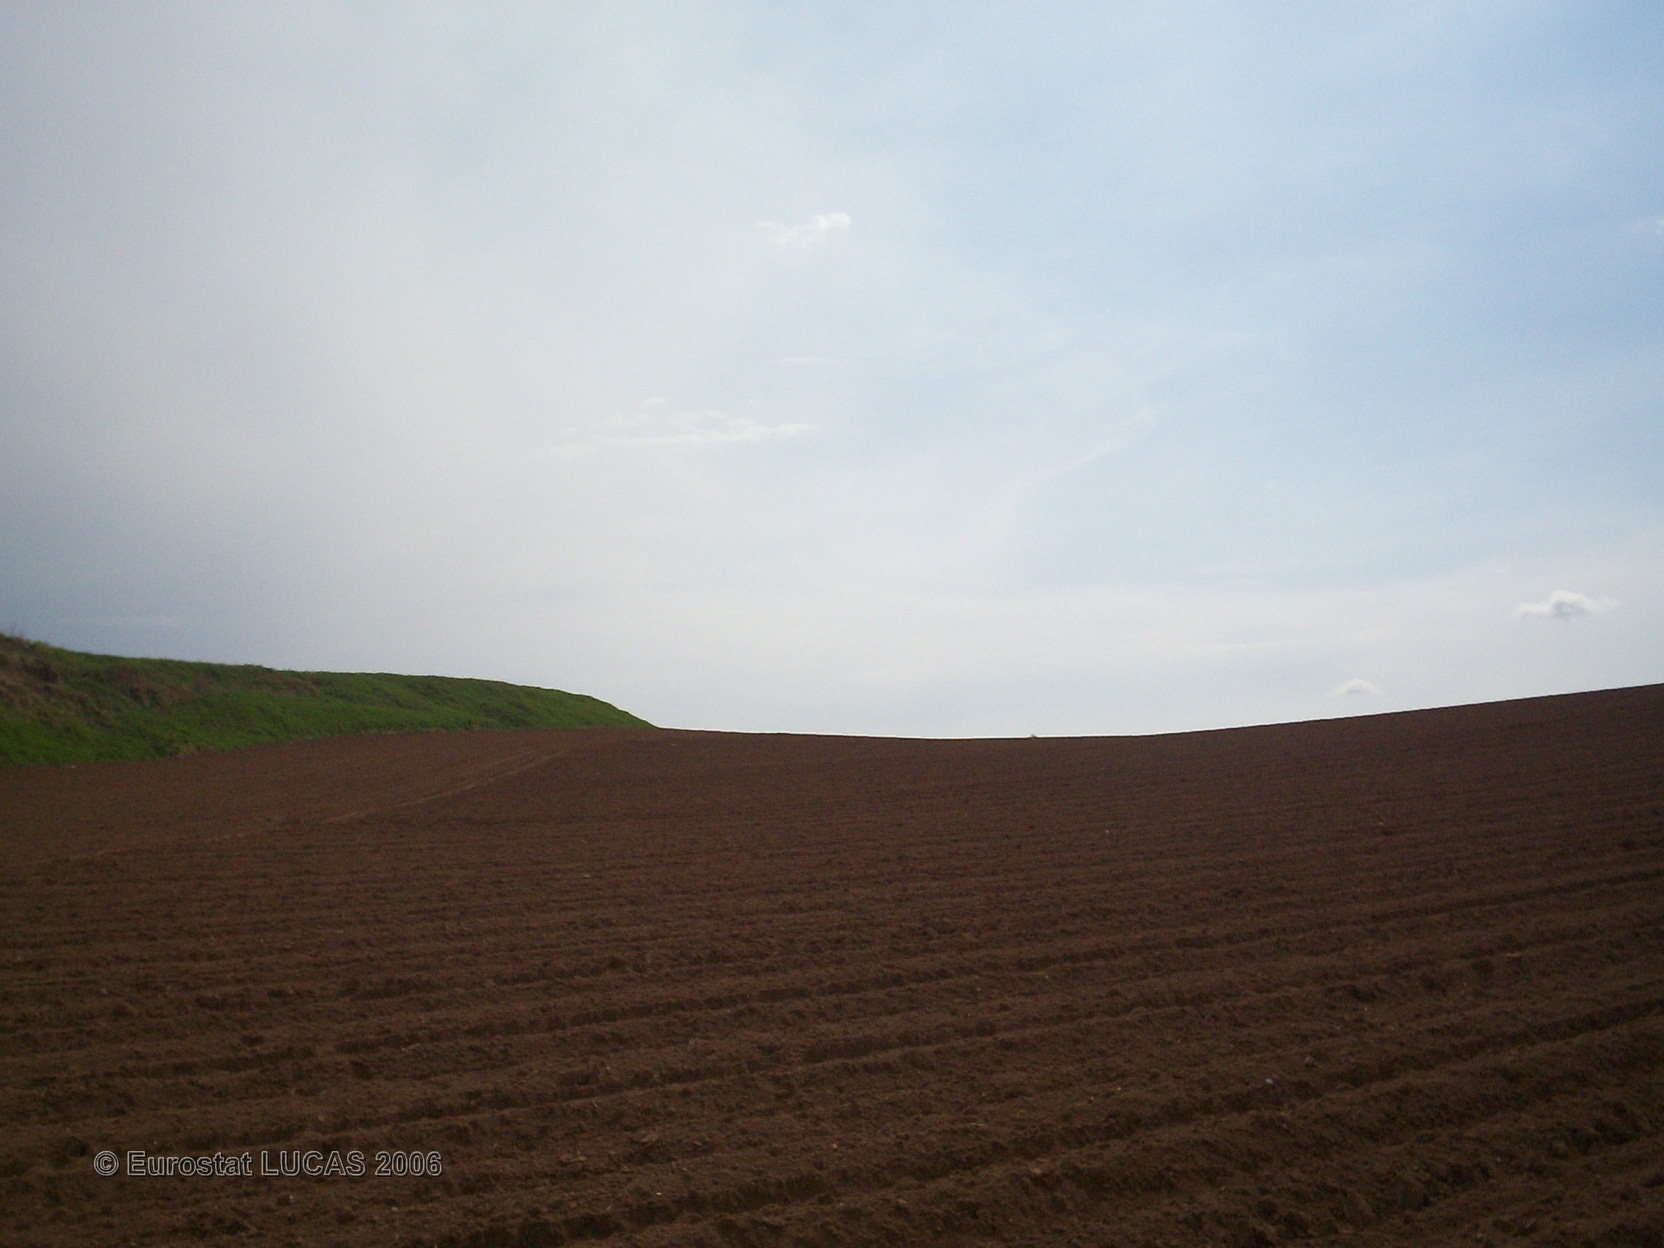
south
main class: Cropland
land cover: Potatoes
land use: Agriculture (excluding fallow land and kitchen gardens)
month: April
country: FR
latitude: 49.9429
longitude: 2.5889
